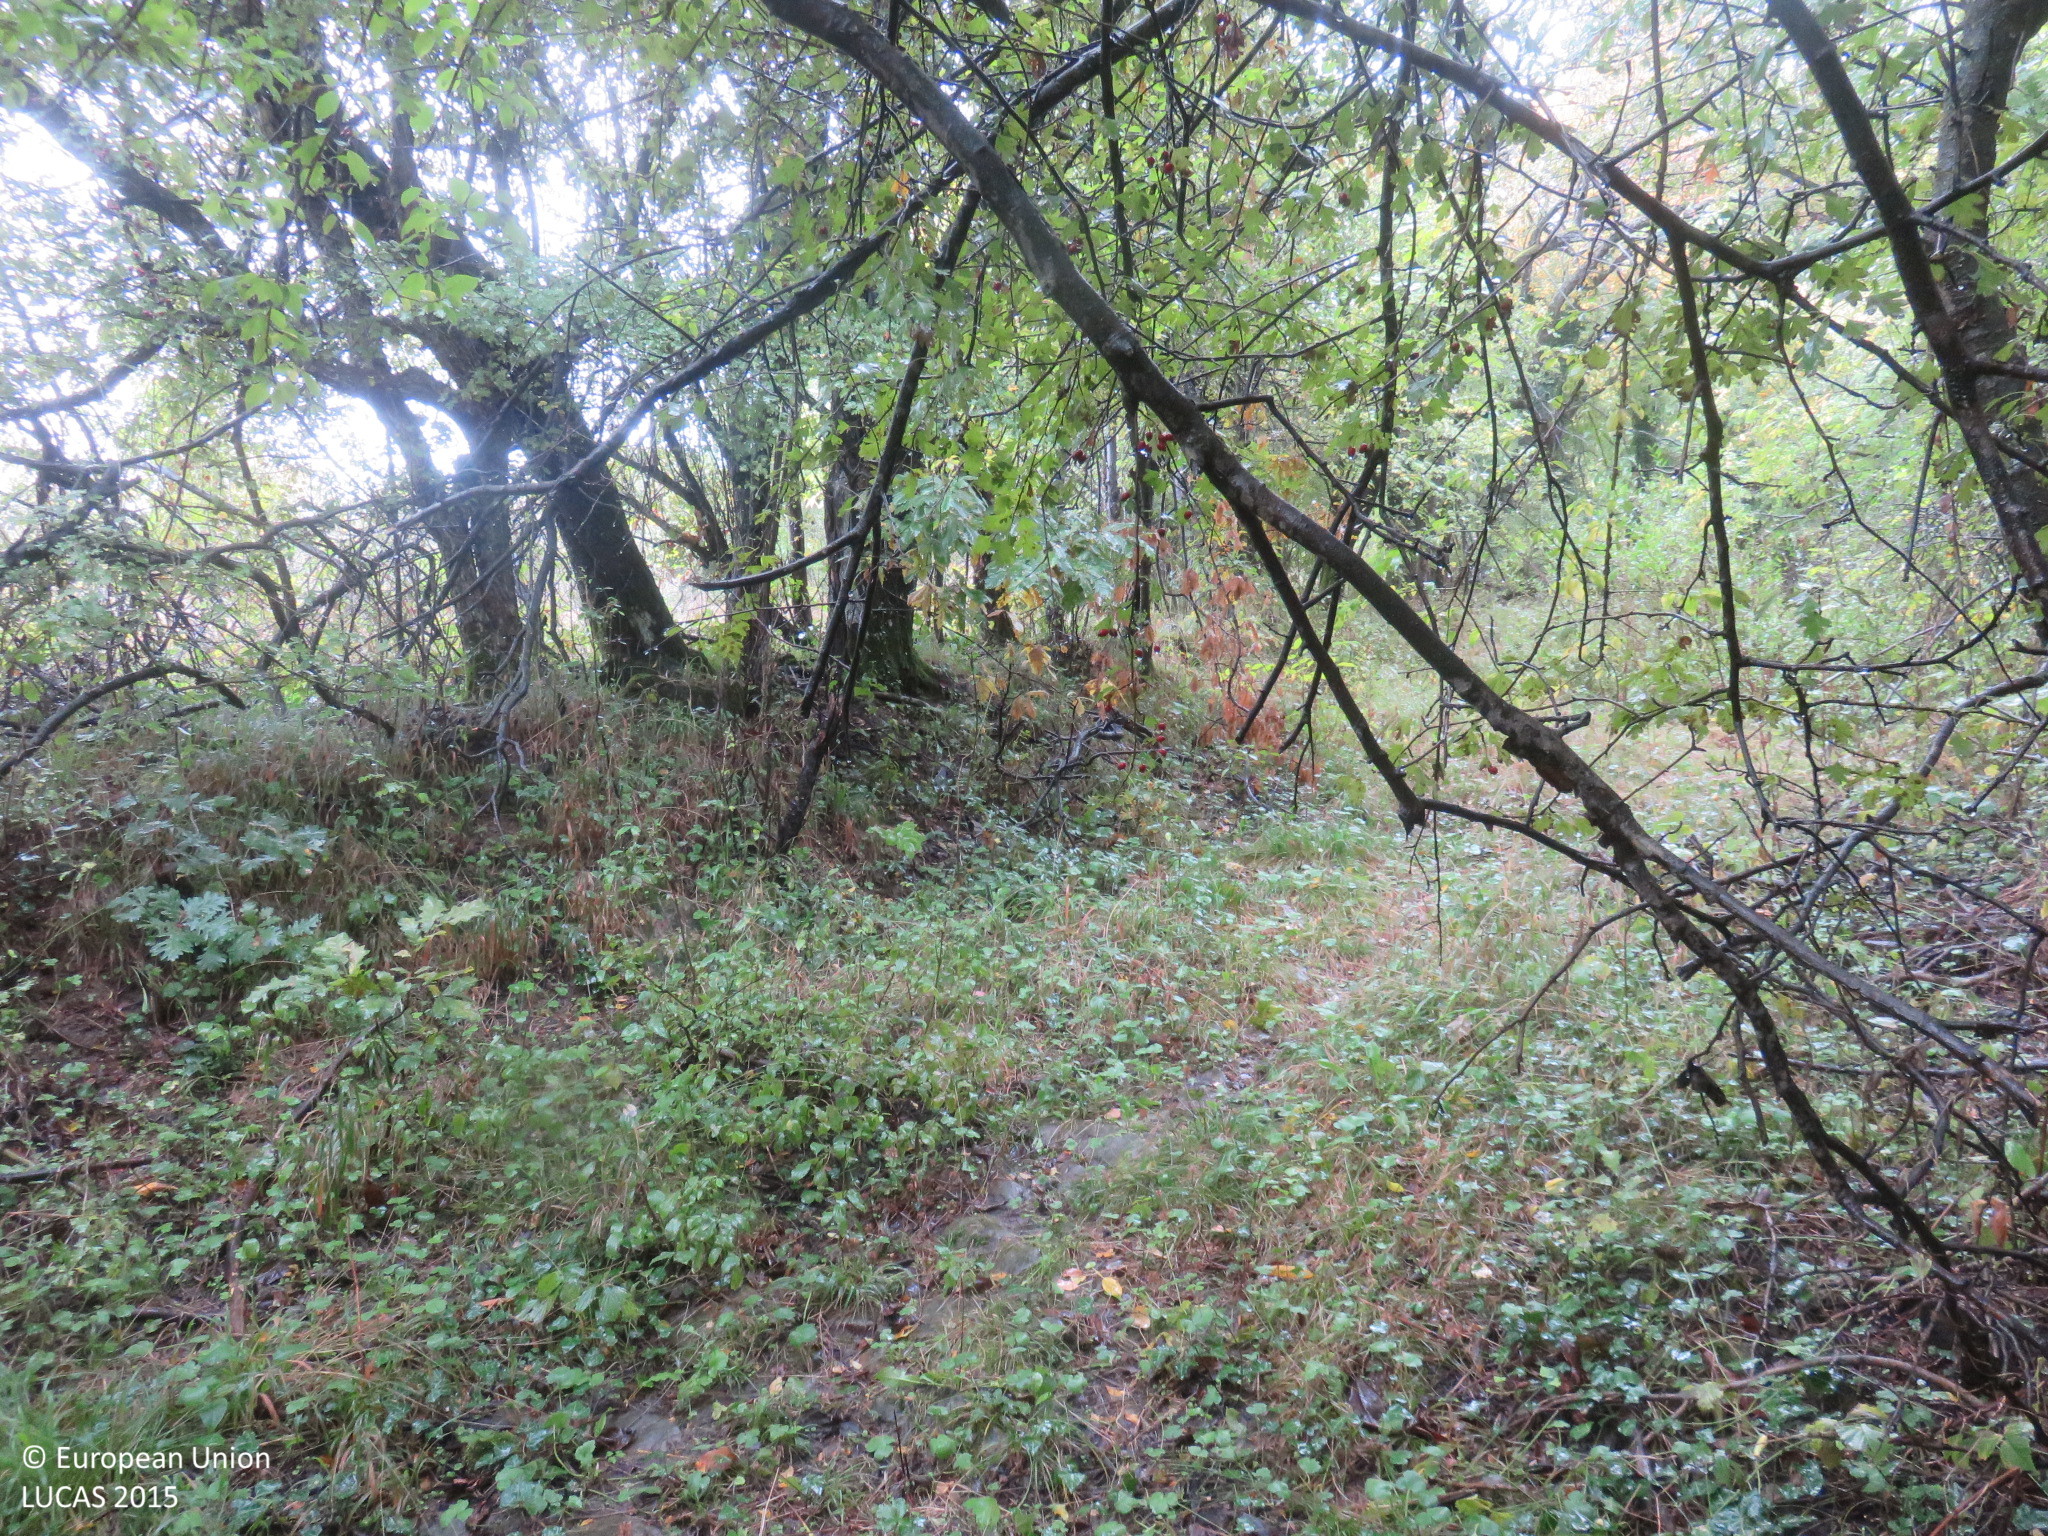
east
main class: Woodland
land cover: Broadleaved woodland
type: mesophytic deciduous forest
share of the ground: > 75 %
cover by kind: broadleaved forest trees 85 %, herbaceous plants 10 %, shrubs 5 %
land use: Abandoned areas
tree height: < 5 m
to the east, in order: Broadleaved woodland; Tracks; Broadleaved woodland; Electric lines; Broadleaved woodland; Shrubland with sparse tree cover
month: October
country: BG
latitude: 42.9318
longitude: 25.4269
